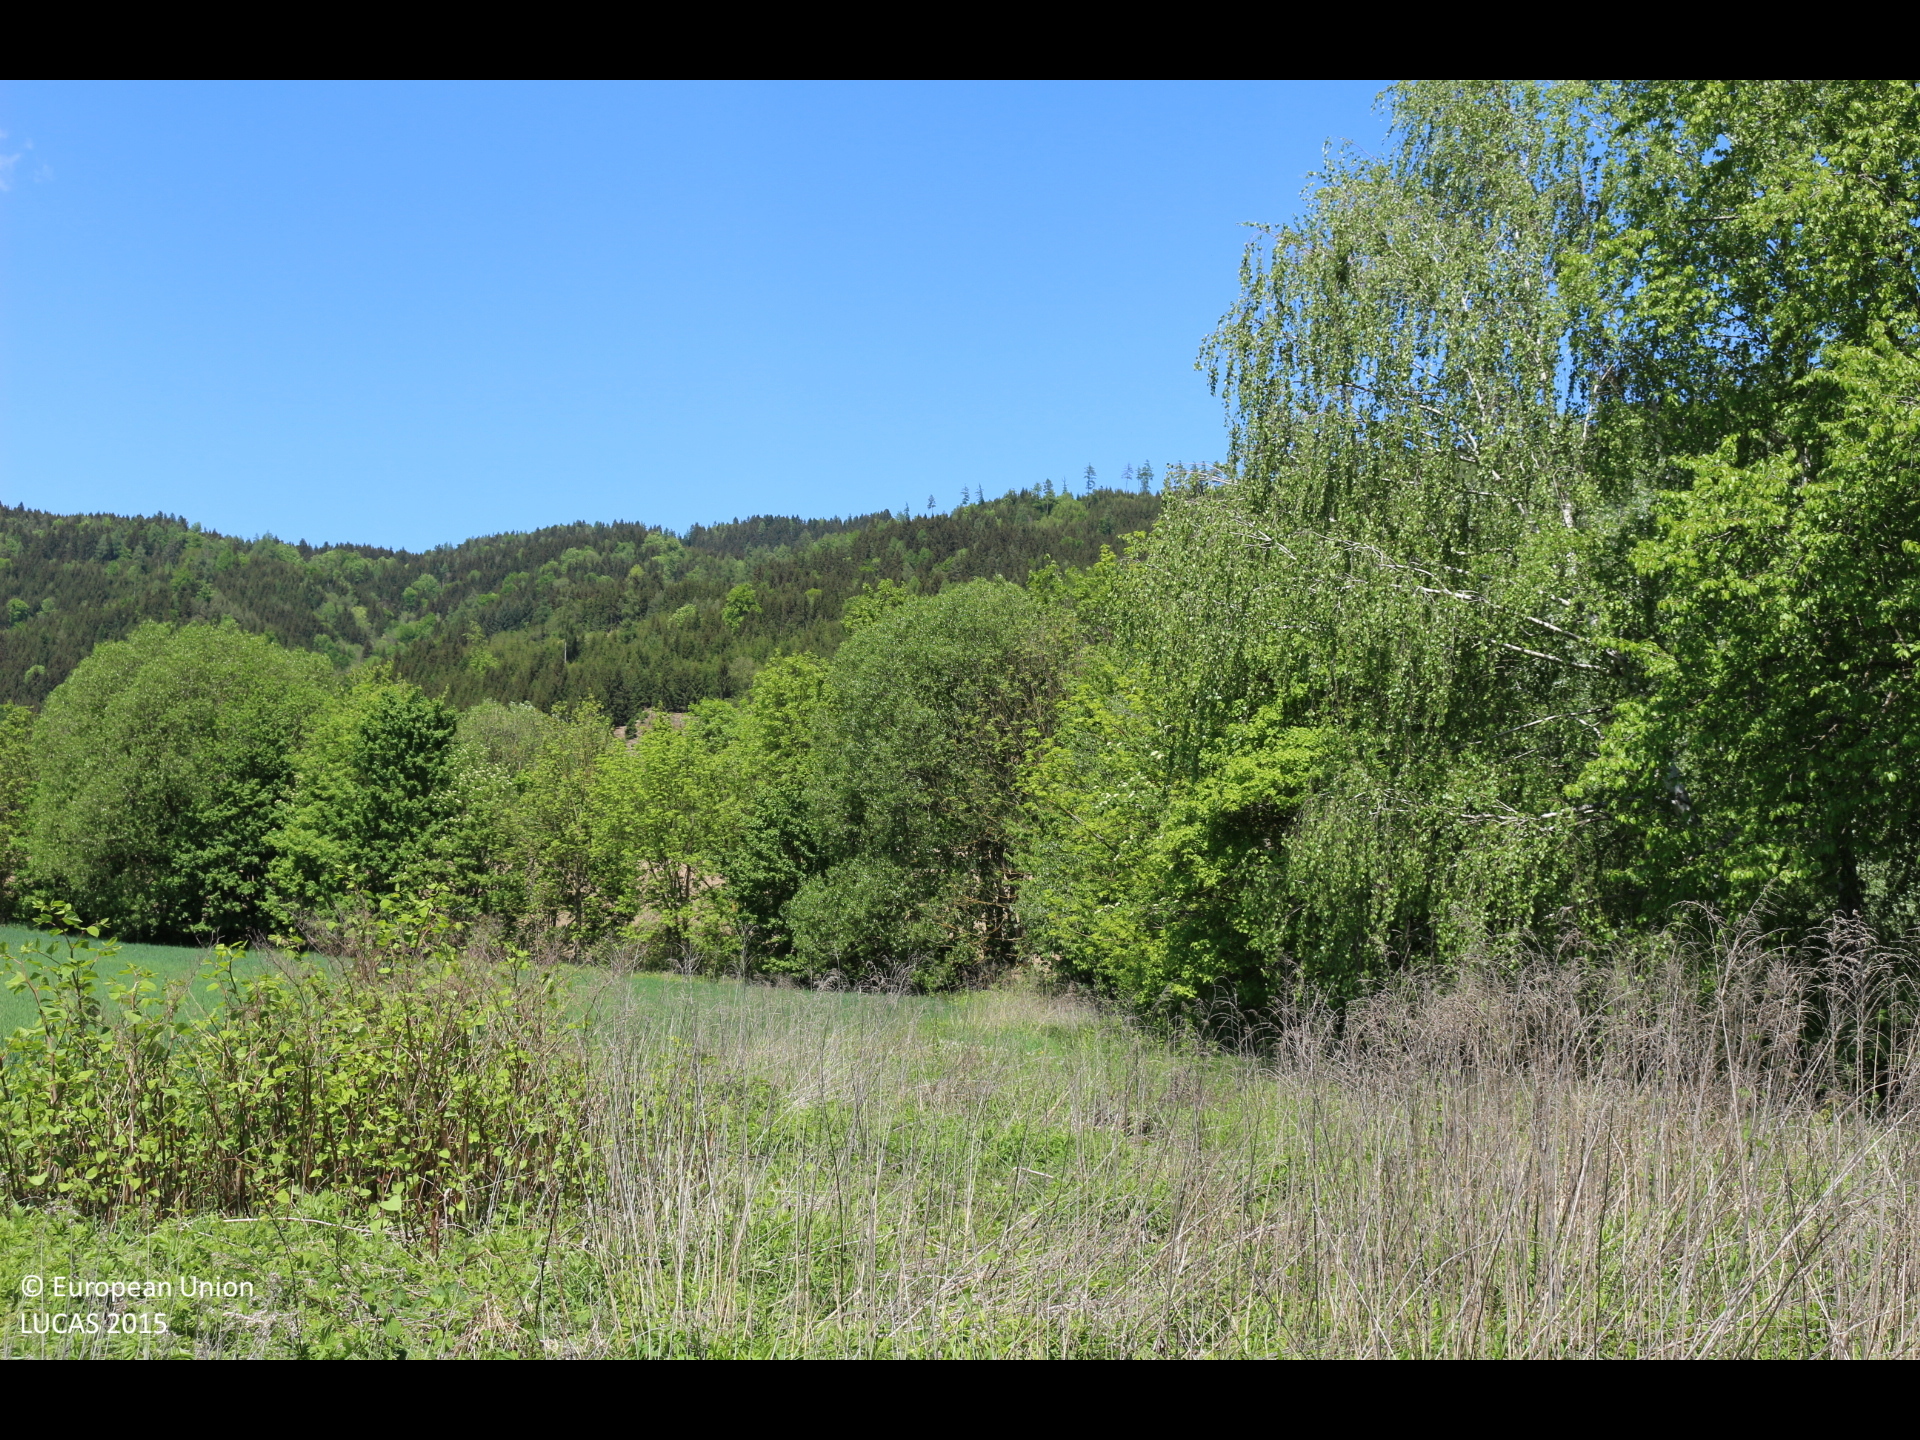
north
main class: Grassland
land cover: Spontaneously vegetated surfaces
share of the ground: > 75 %
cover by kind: herbaceous plants 95 %, shrubs 5 %
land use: Fallow land
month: May
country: AT
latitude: 46.6912
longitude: 14.4566
